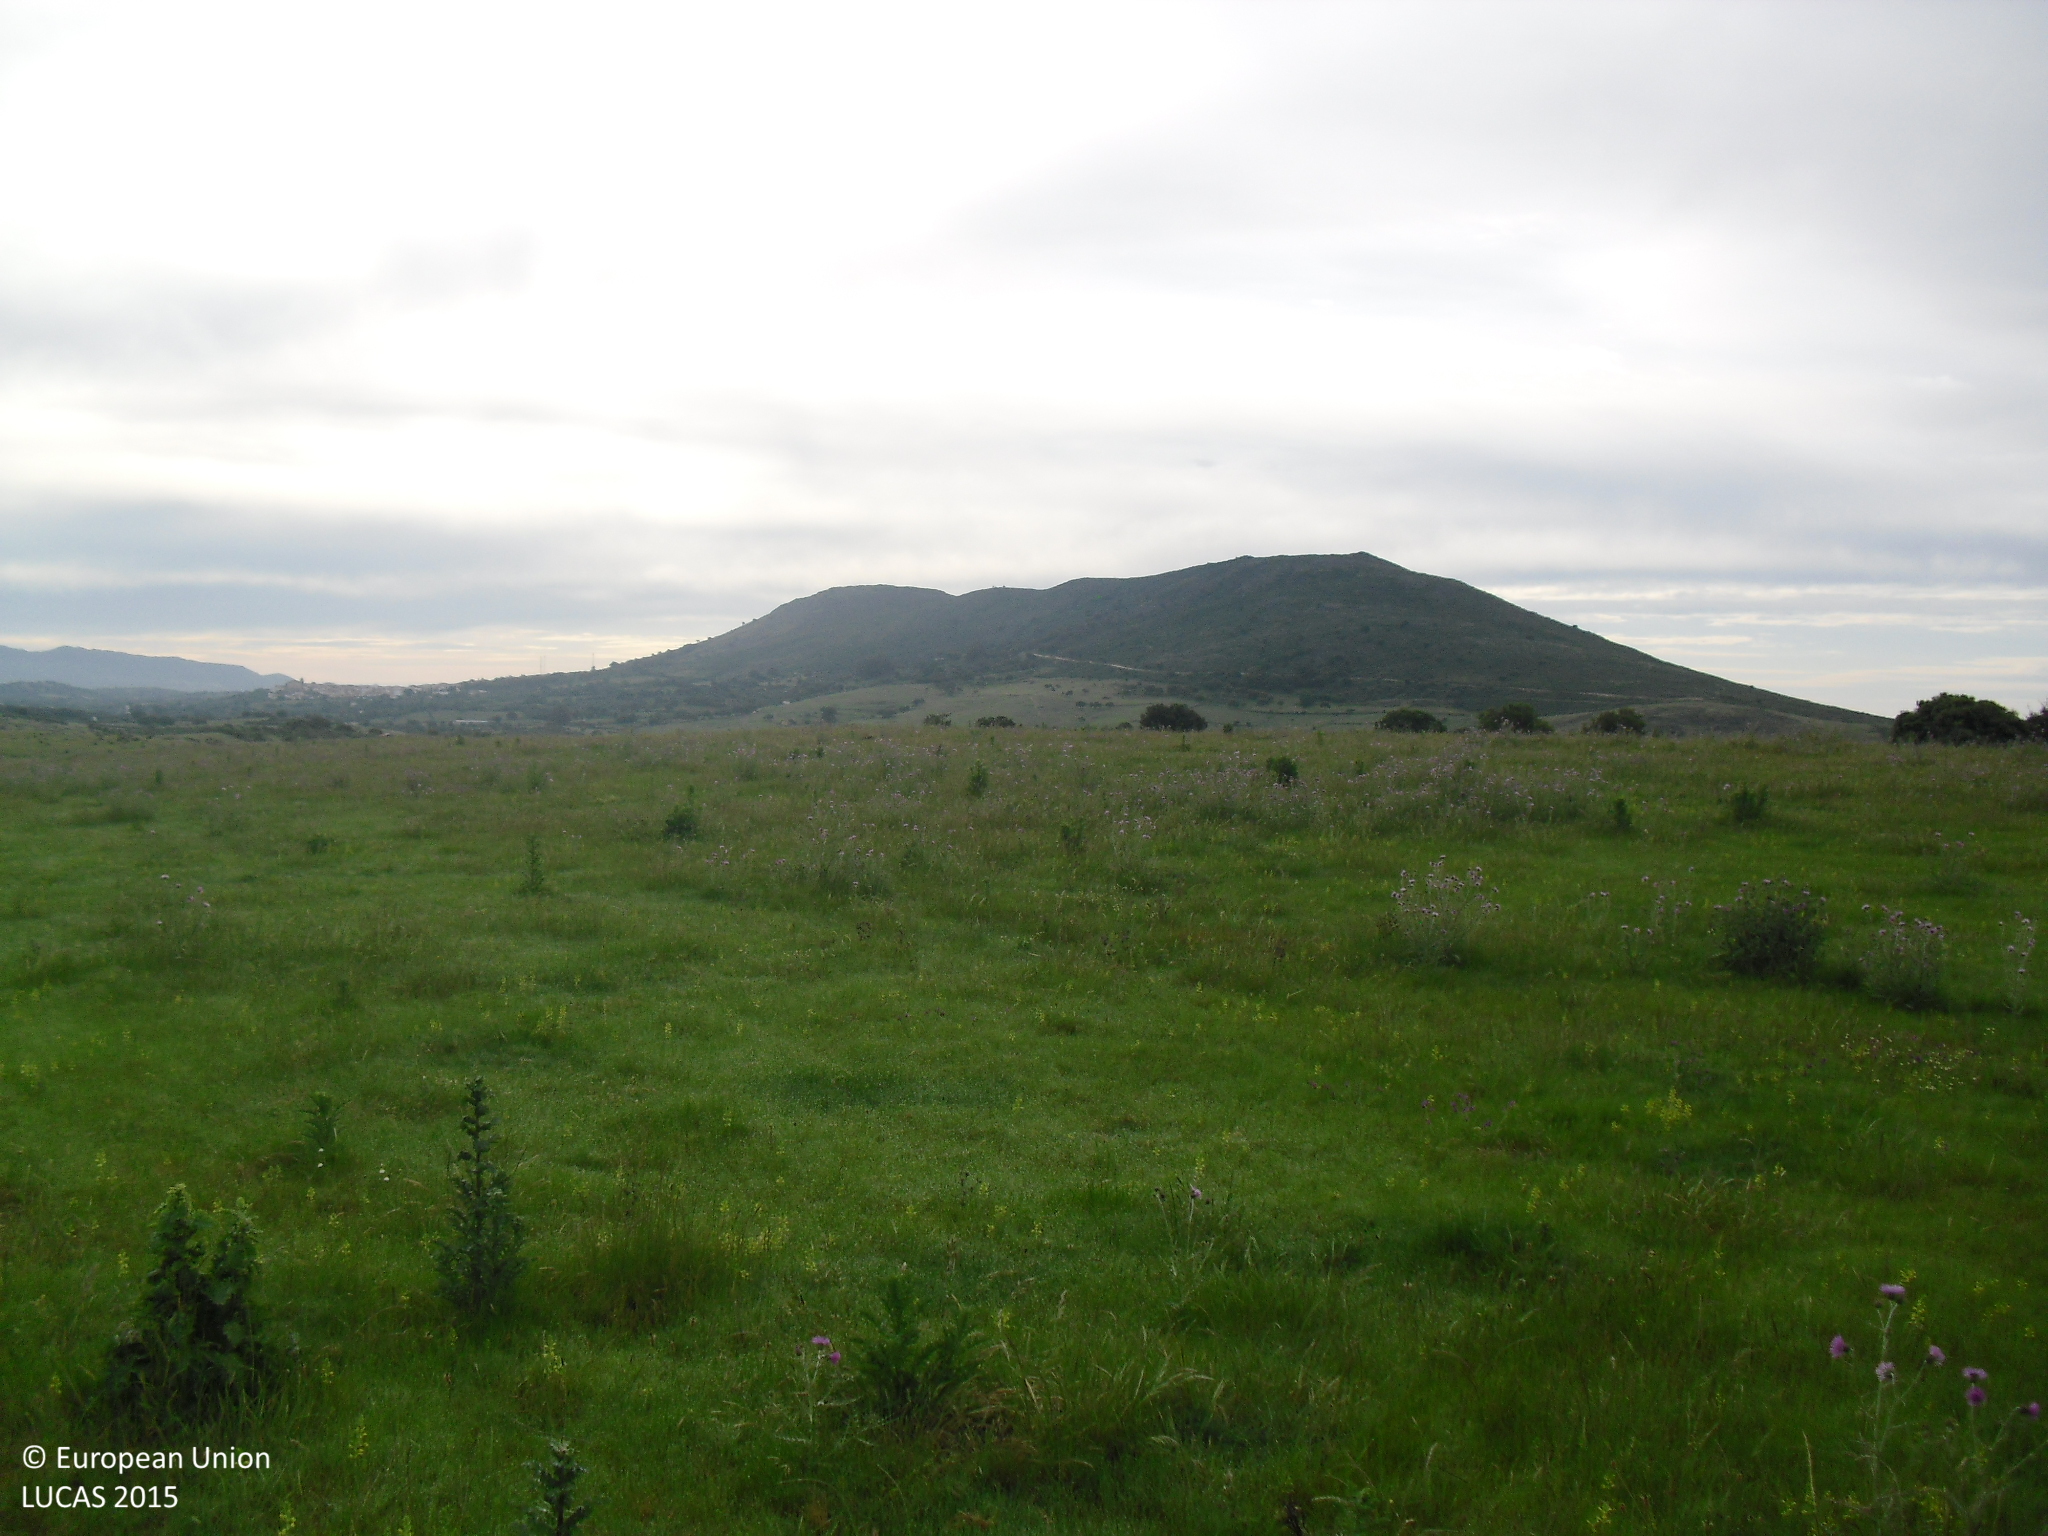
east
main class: Grassland
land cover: Grassland without tree/shrub cover
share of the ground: > 75 %
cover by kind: herbaceous plants 100 %
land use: Agriculture (excluding fallow land and kitchen gardens)
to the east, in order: Grassland without tree/shrub cover
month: May
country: ES
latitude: 39.3336
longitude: -5.5377
